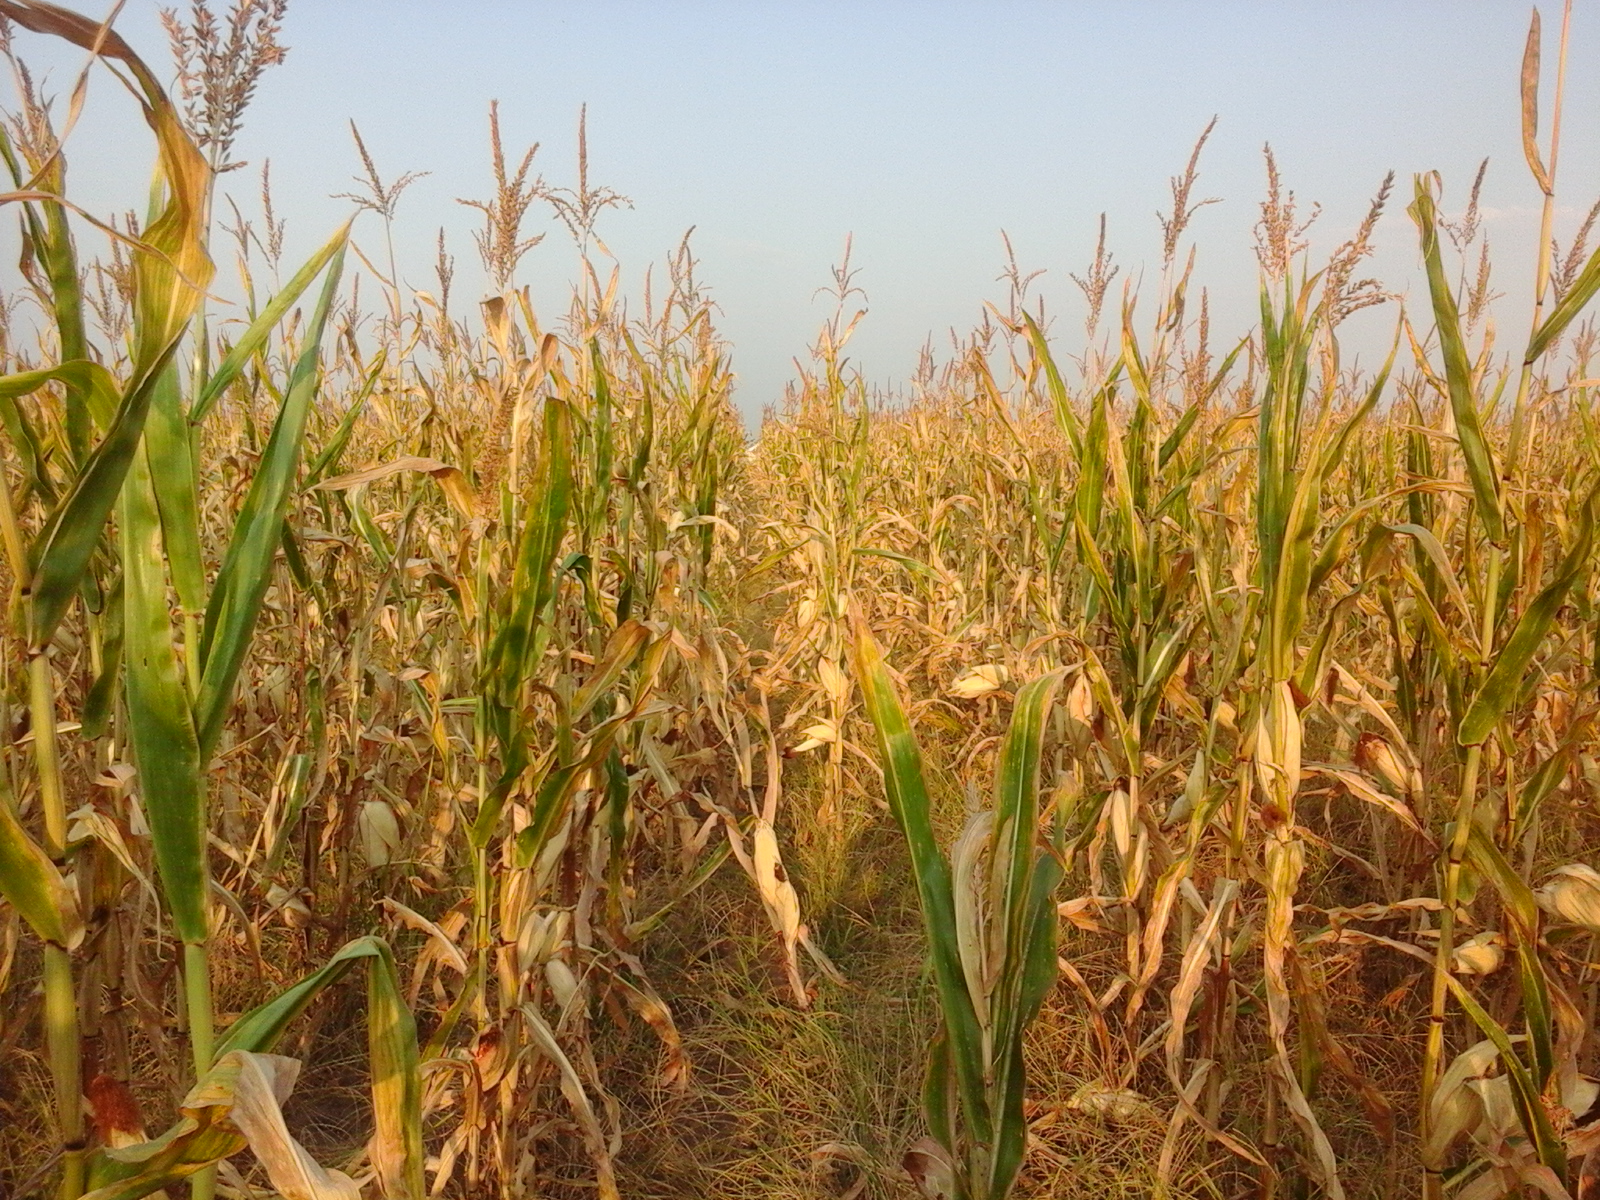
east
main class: Cropland
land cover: Maize
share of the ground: > 75 %
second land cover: Spontaneously vegetated surfaces
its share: > 75 %
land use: Agriculture (excluding fallow land and kitchen gardens)
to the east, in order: Maize; Spontaneously vegetated surfaces; Grass margins; Tracks; Grass margins; Sunflower
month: August
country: RO
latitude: 44.0574
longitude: 23.2907
